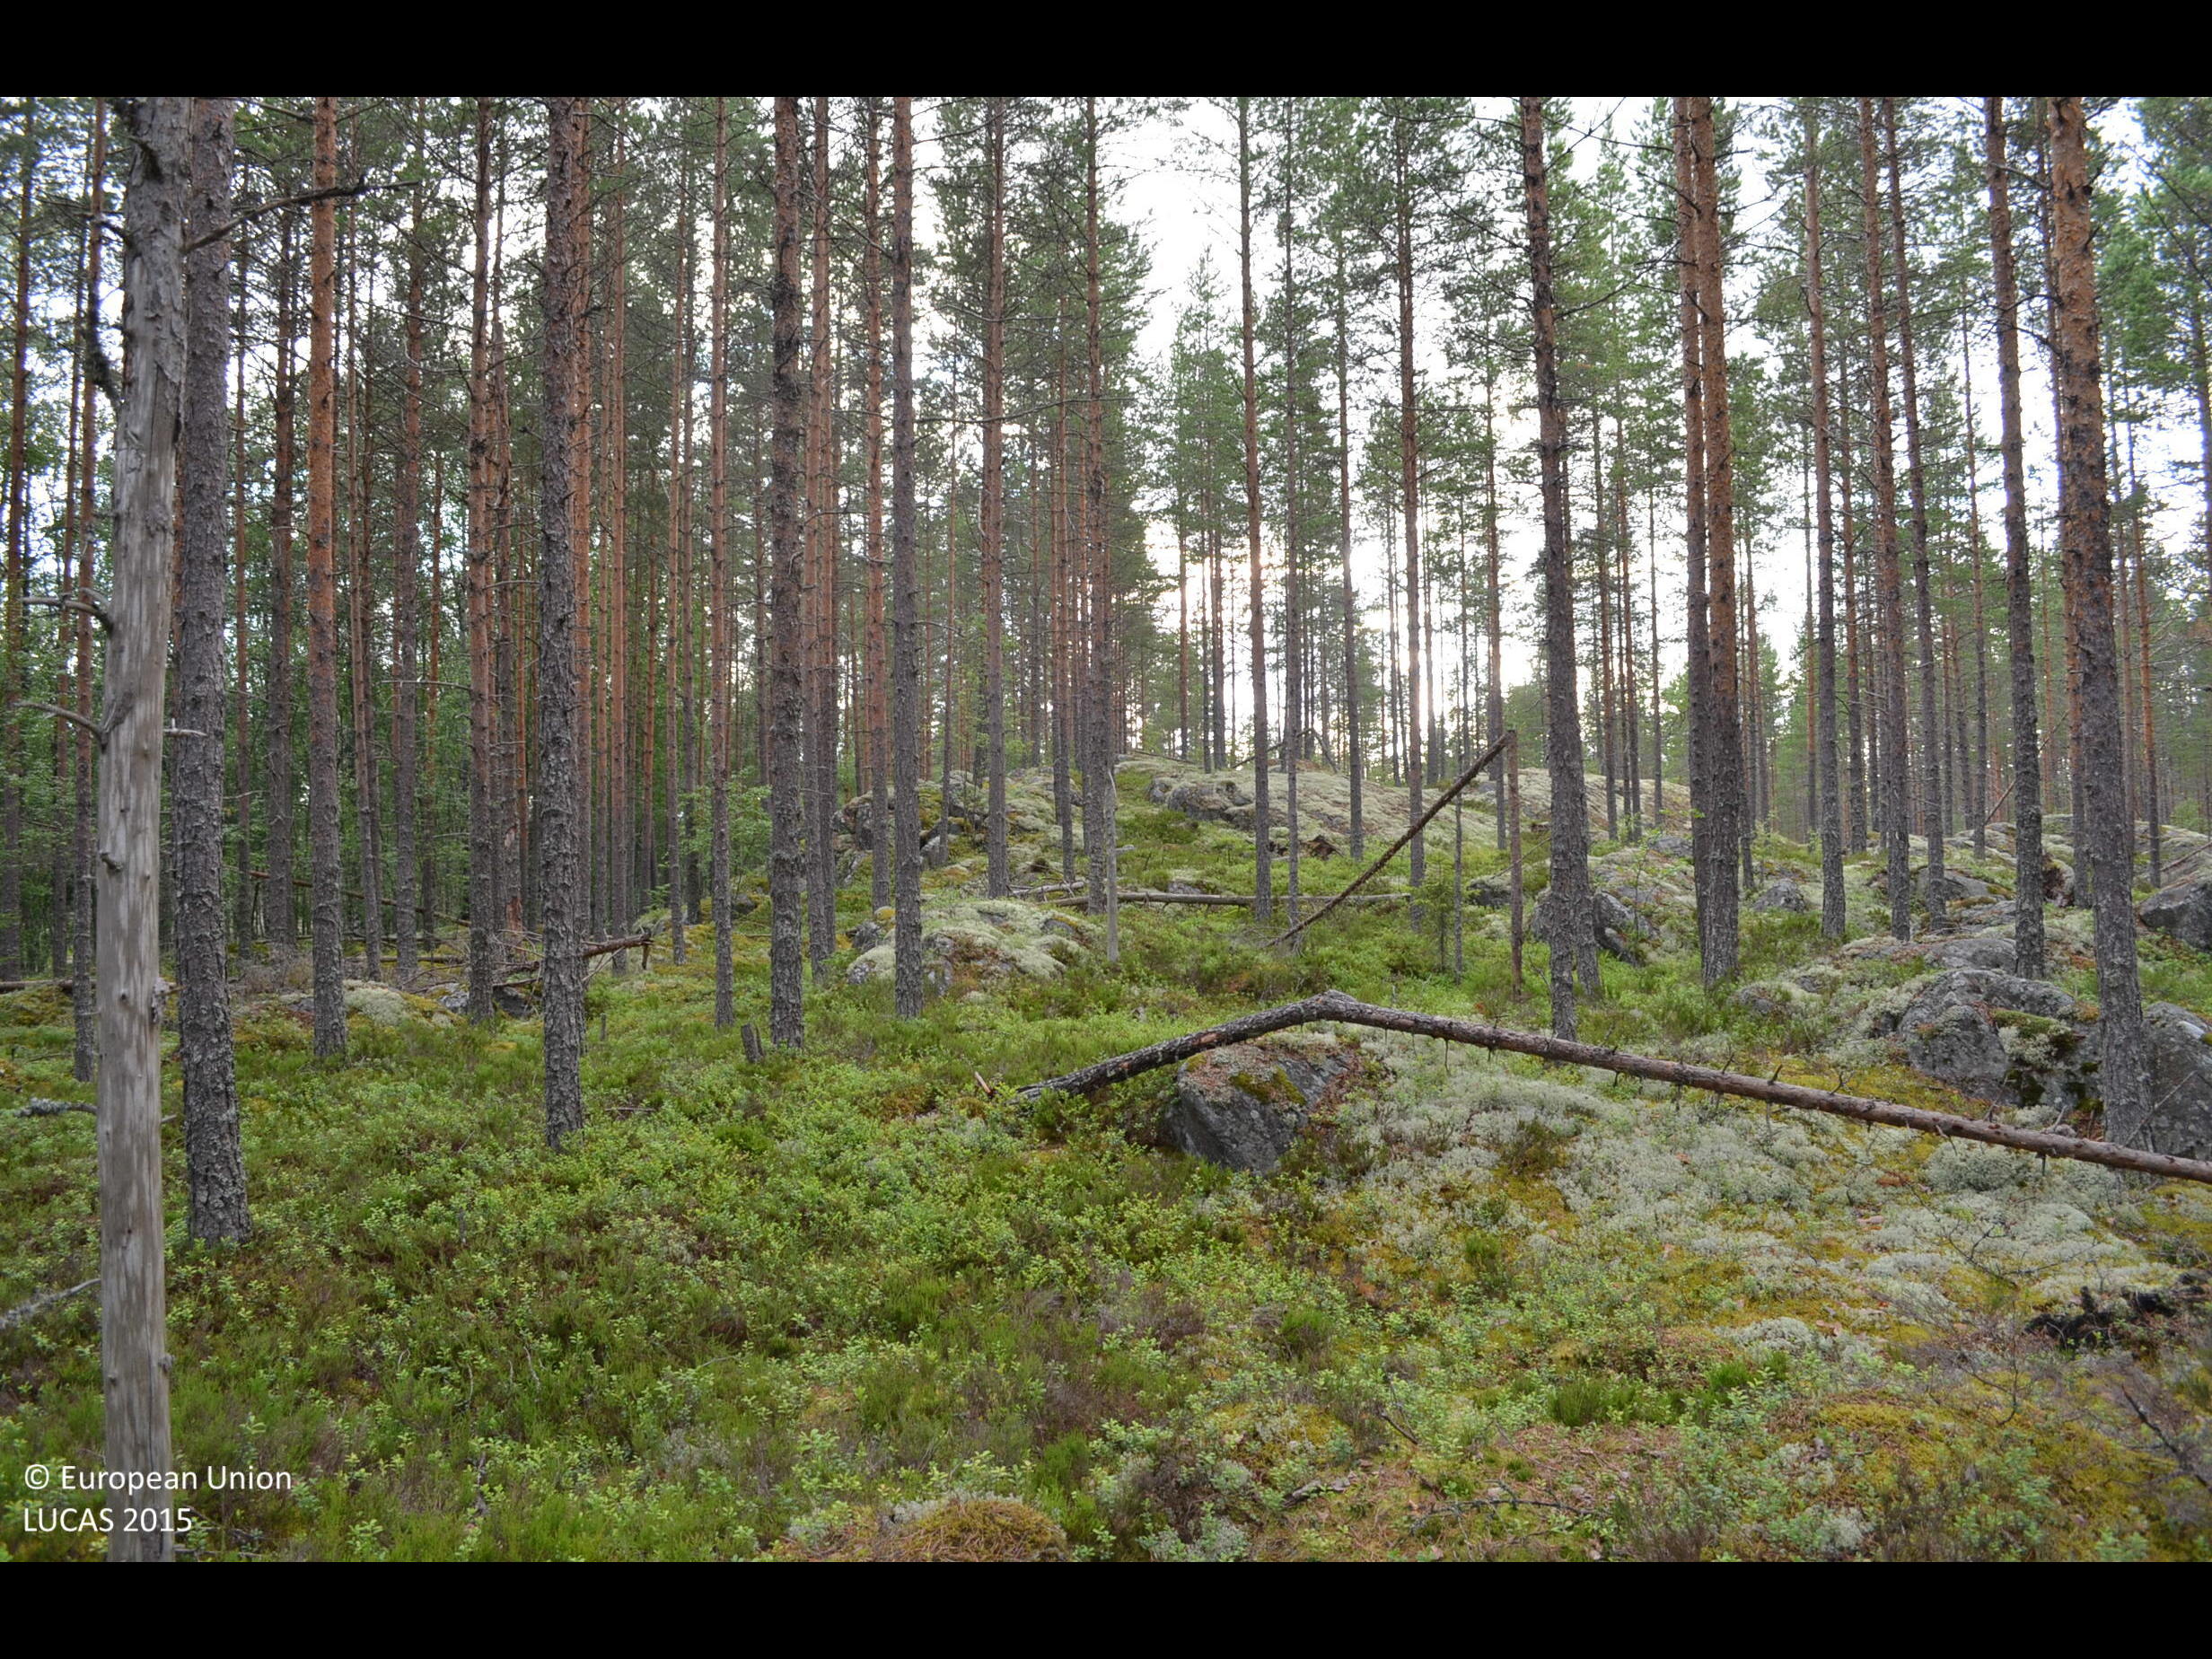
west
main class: Woodland
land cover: Pine dominated coniferous woodland
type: boreal forest
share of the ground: 50 - 75 %
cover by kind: coniferous forest trees 60 %, shrubs 20 %, lichens and mosses 20 %
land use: Forestry
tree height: > 5 m
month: July
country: FI
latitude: 62.2085
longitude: 23.4340
